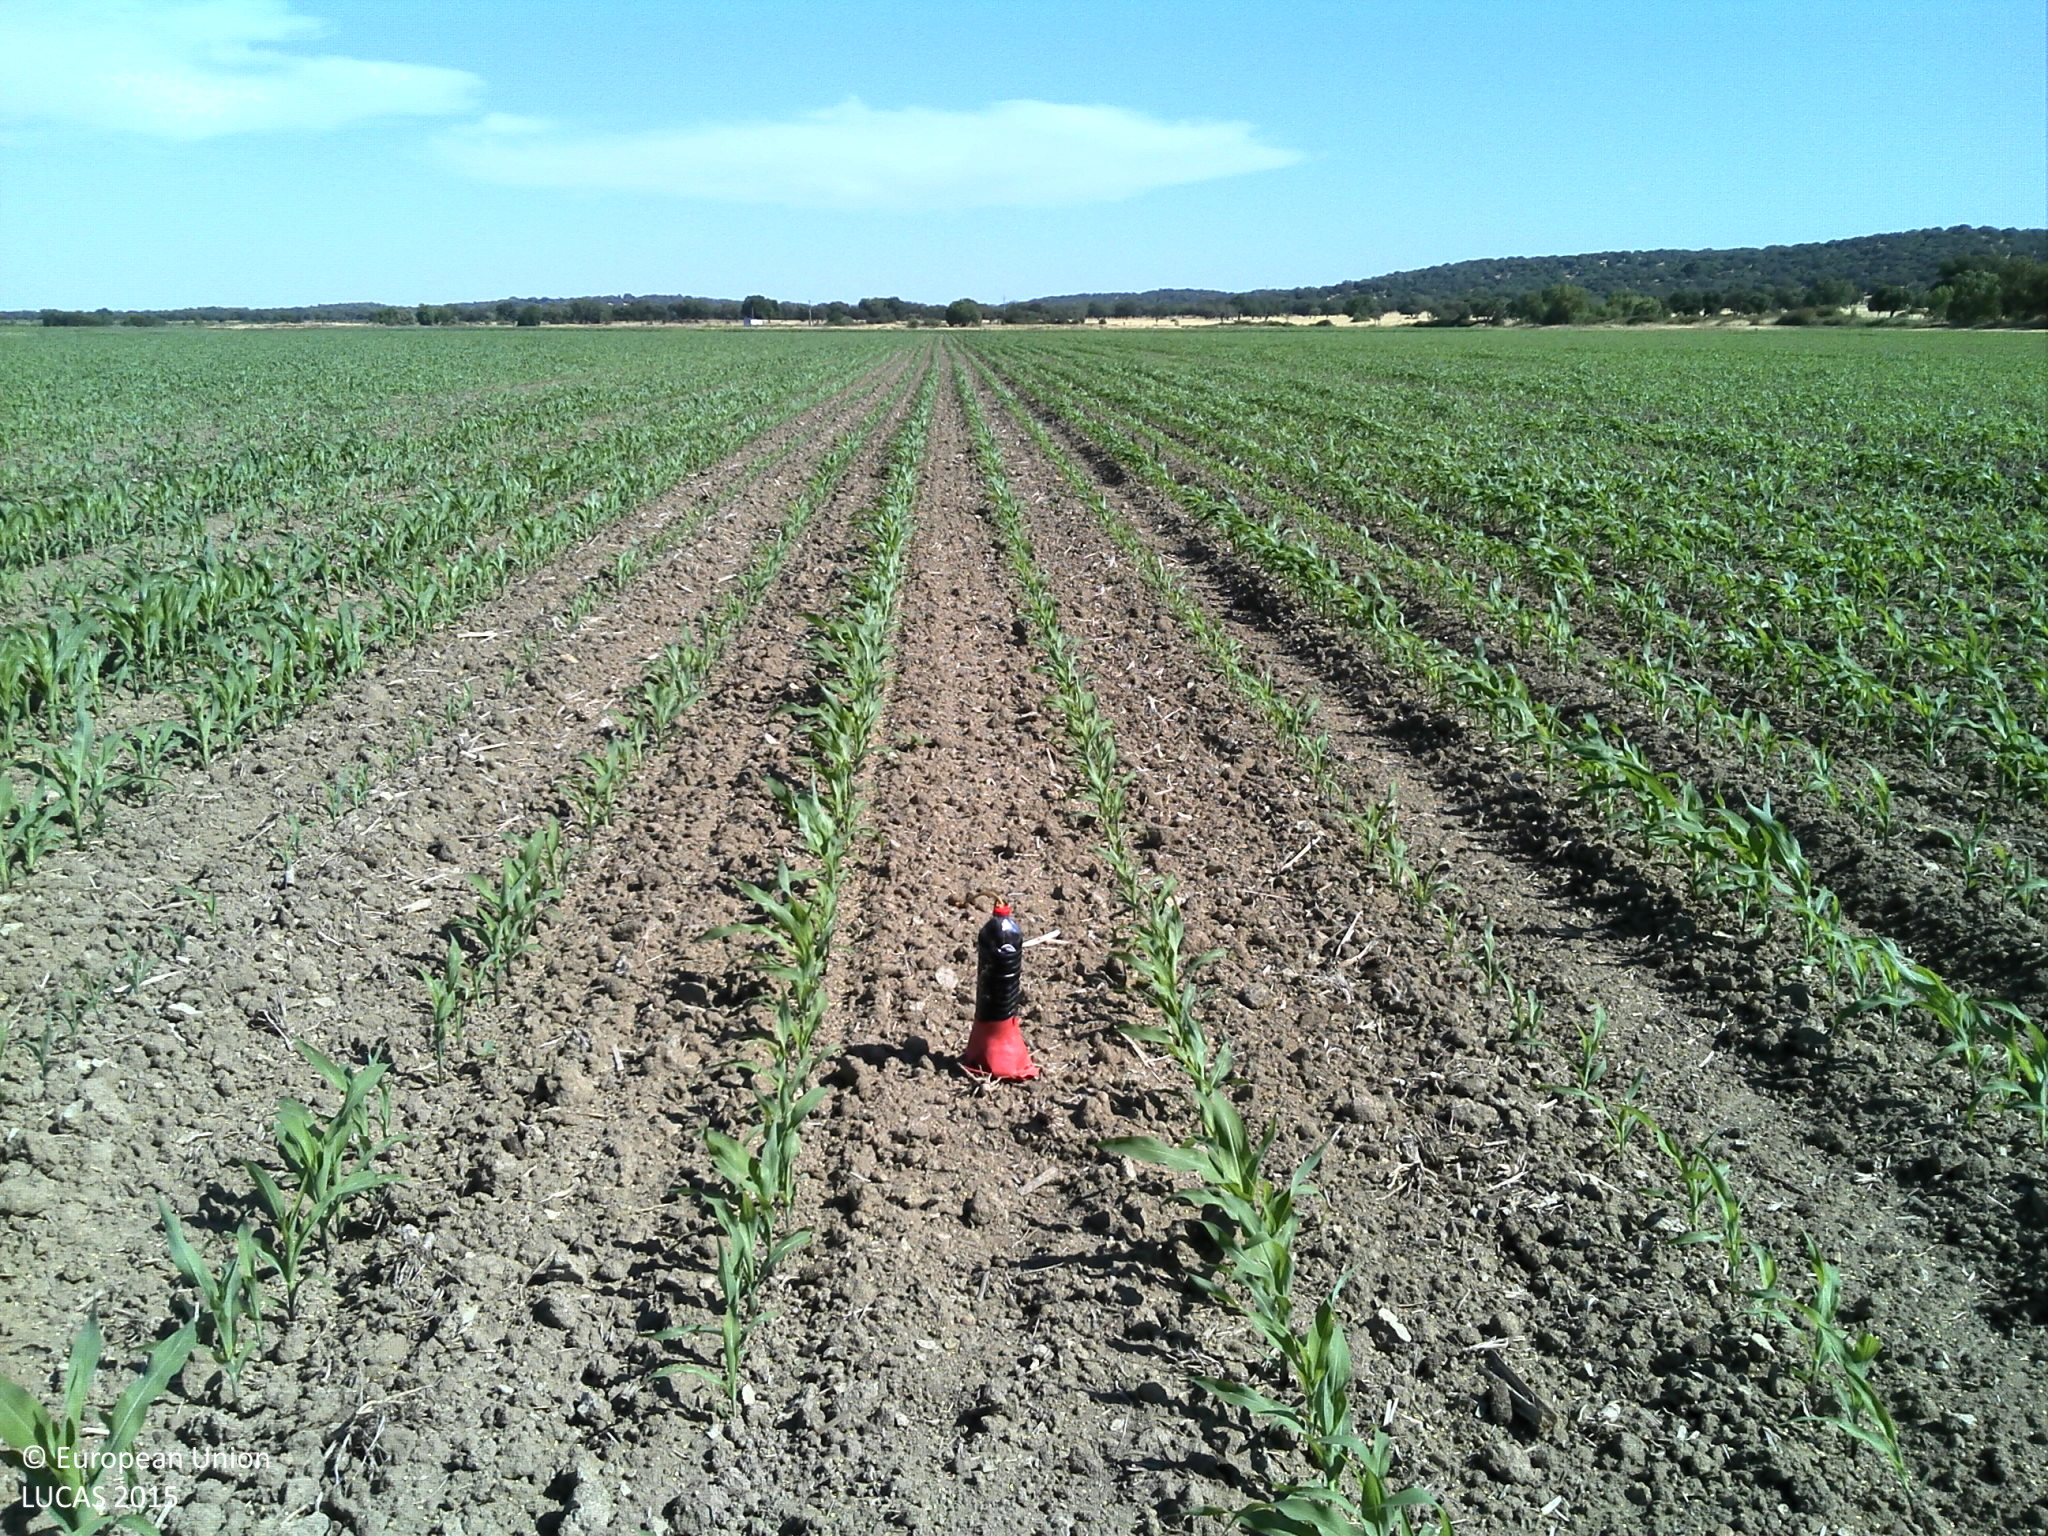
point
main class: Cropland
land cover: Maize
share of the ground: 10 - 25 %
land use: Agriculture (excluding fallow land and kitchen gardens)
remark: Temporary dry
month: June
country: PT
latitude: 38.3186
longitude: -8.1463
